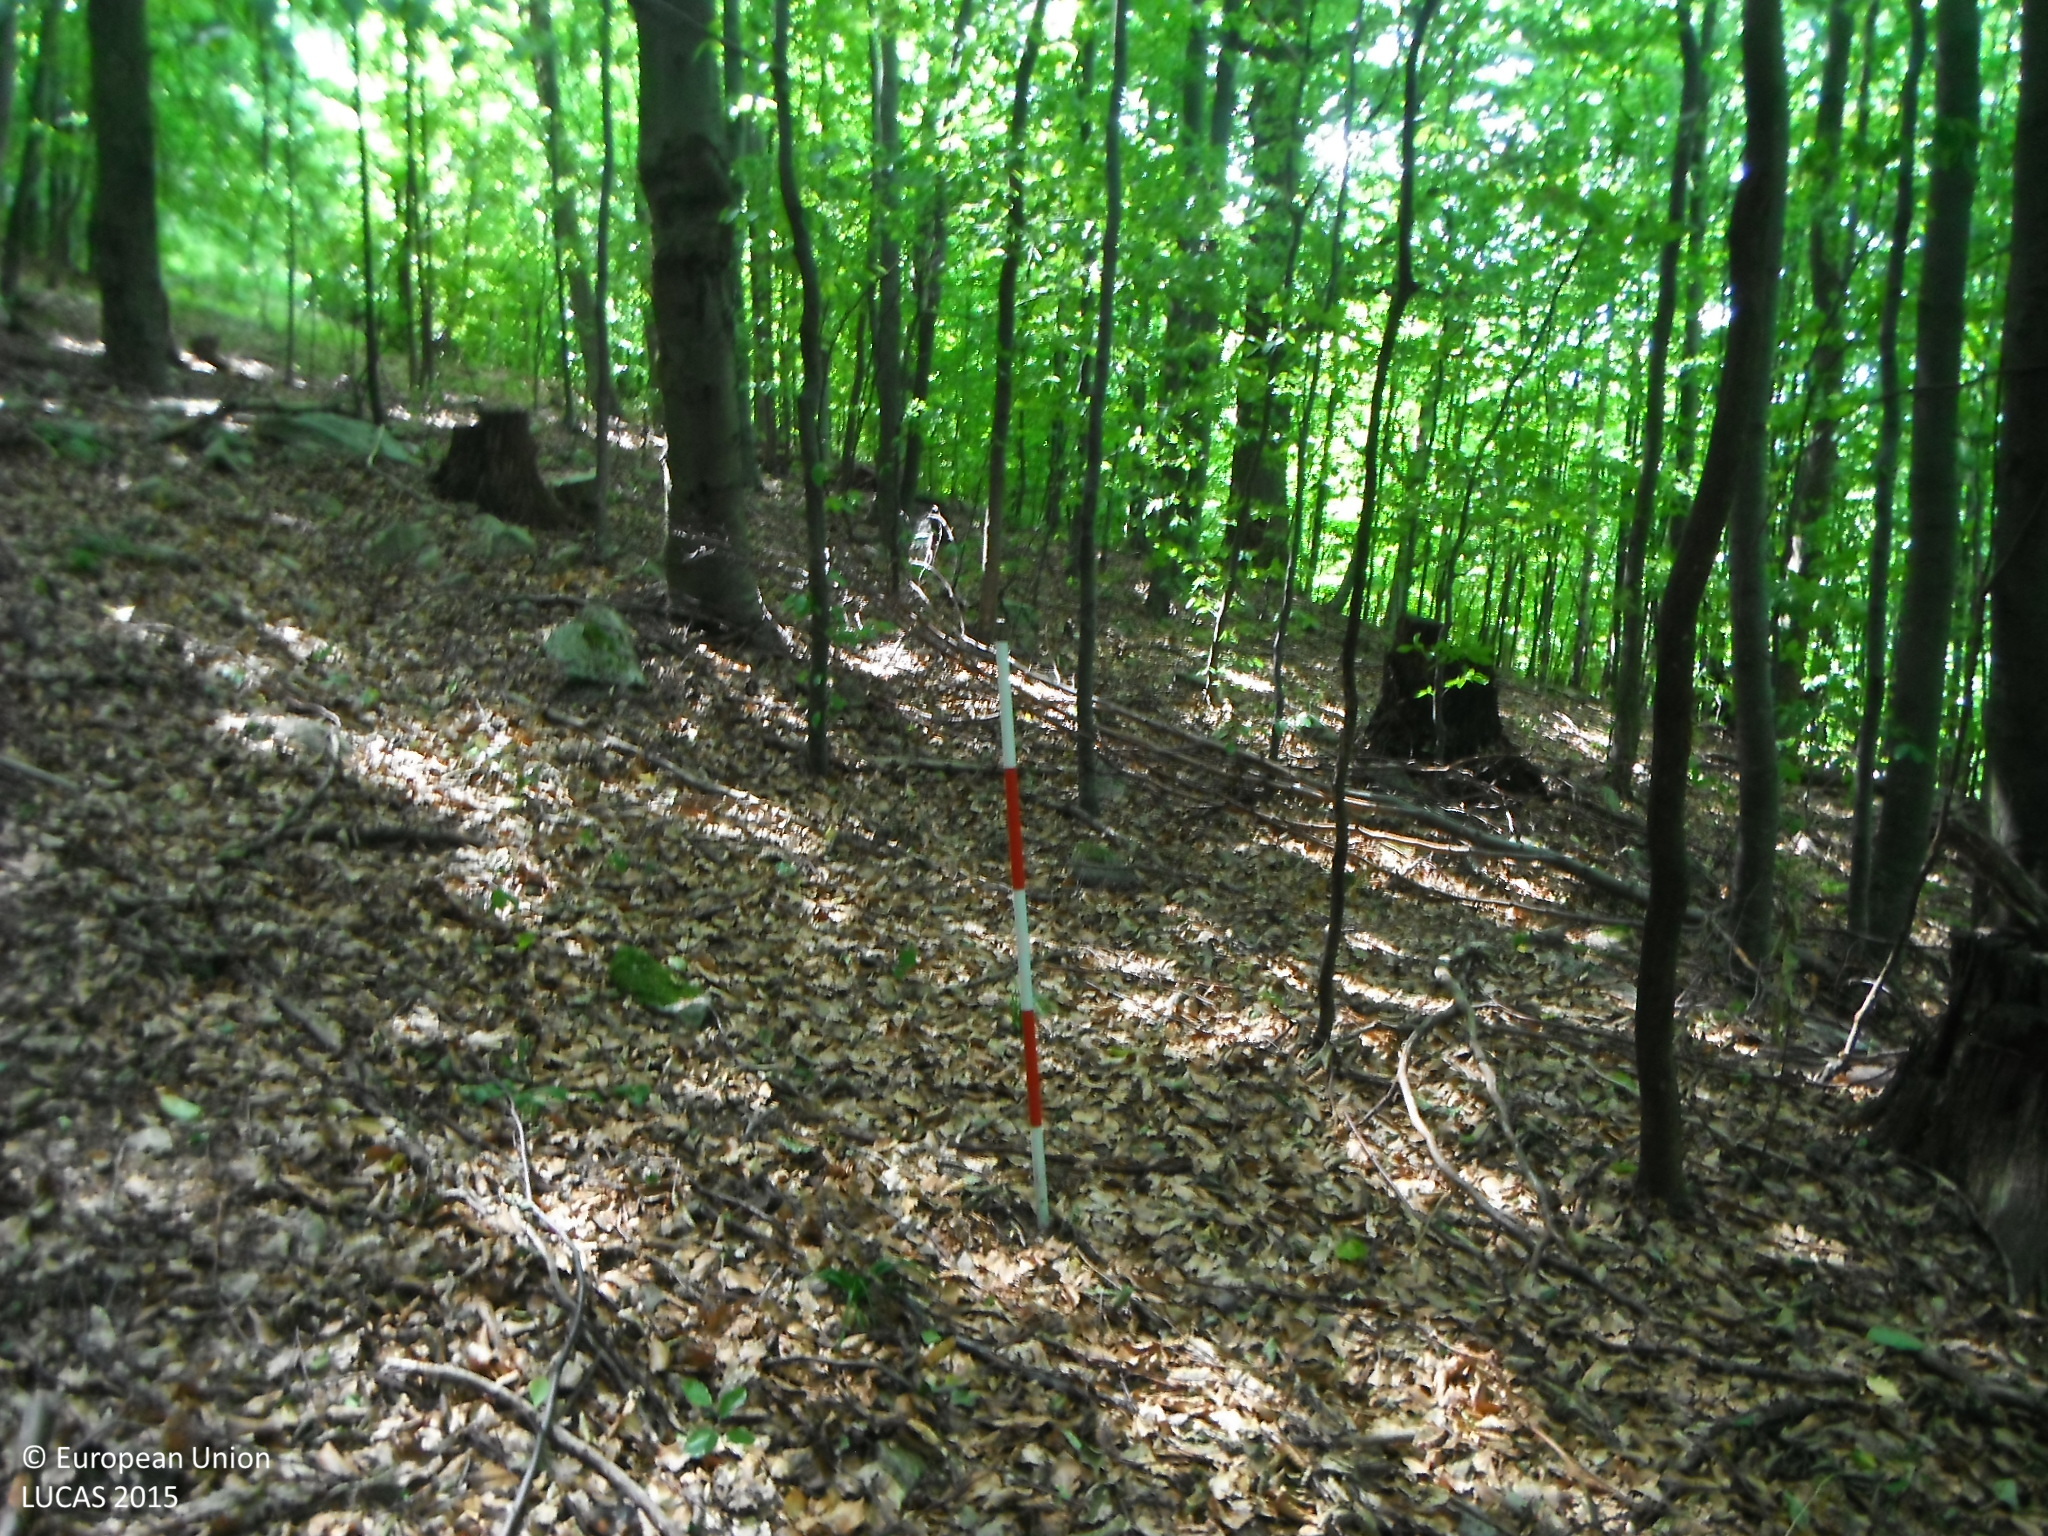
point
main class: Woodland
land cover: Broadleaved woodland
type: beech forest
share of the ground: > 75 %
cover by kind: broadleaved forest trees 100 %
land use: Forestry
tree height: > 5 m
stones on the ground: > 50 %
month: July
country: SK
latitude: 48.7394
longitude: 20.0798
